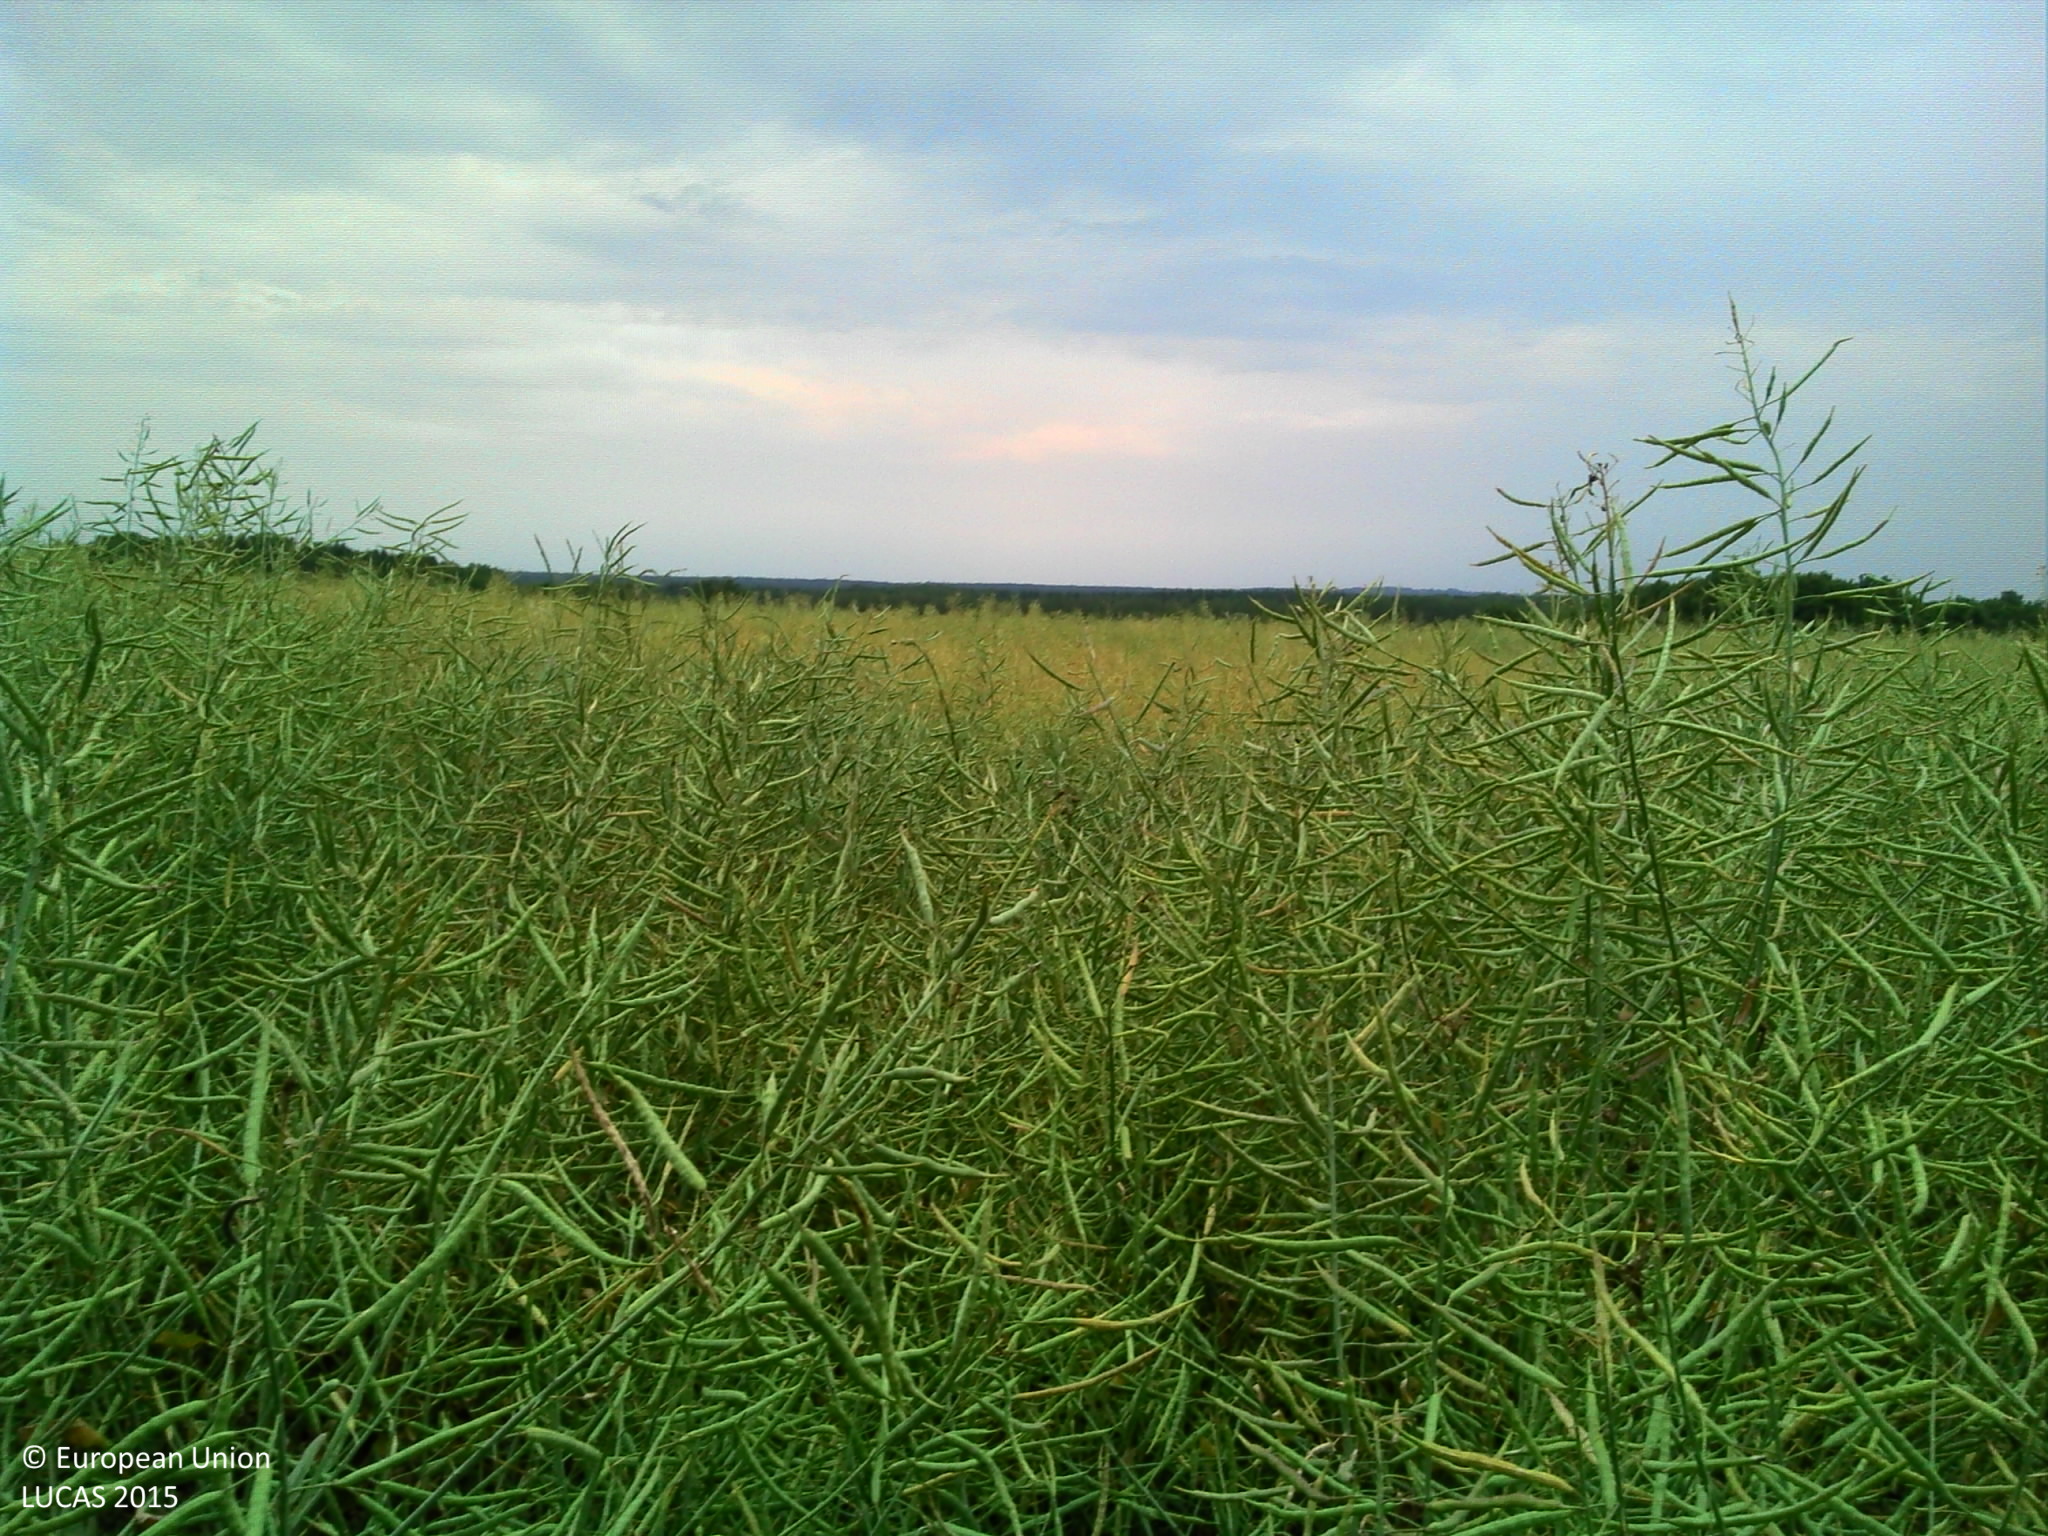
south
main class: Cropland
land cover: Rape and turnip rape
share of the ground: > 75 %
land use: Agriculture (excluding fallow land and kitchen gardens)
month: June
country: FR
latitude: 46.8047
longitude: 2.6700
